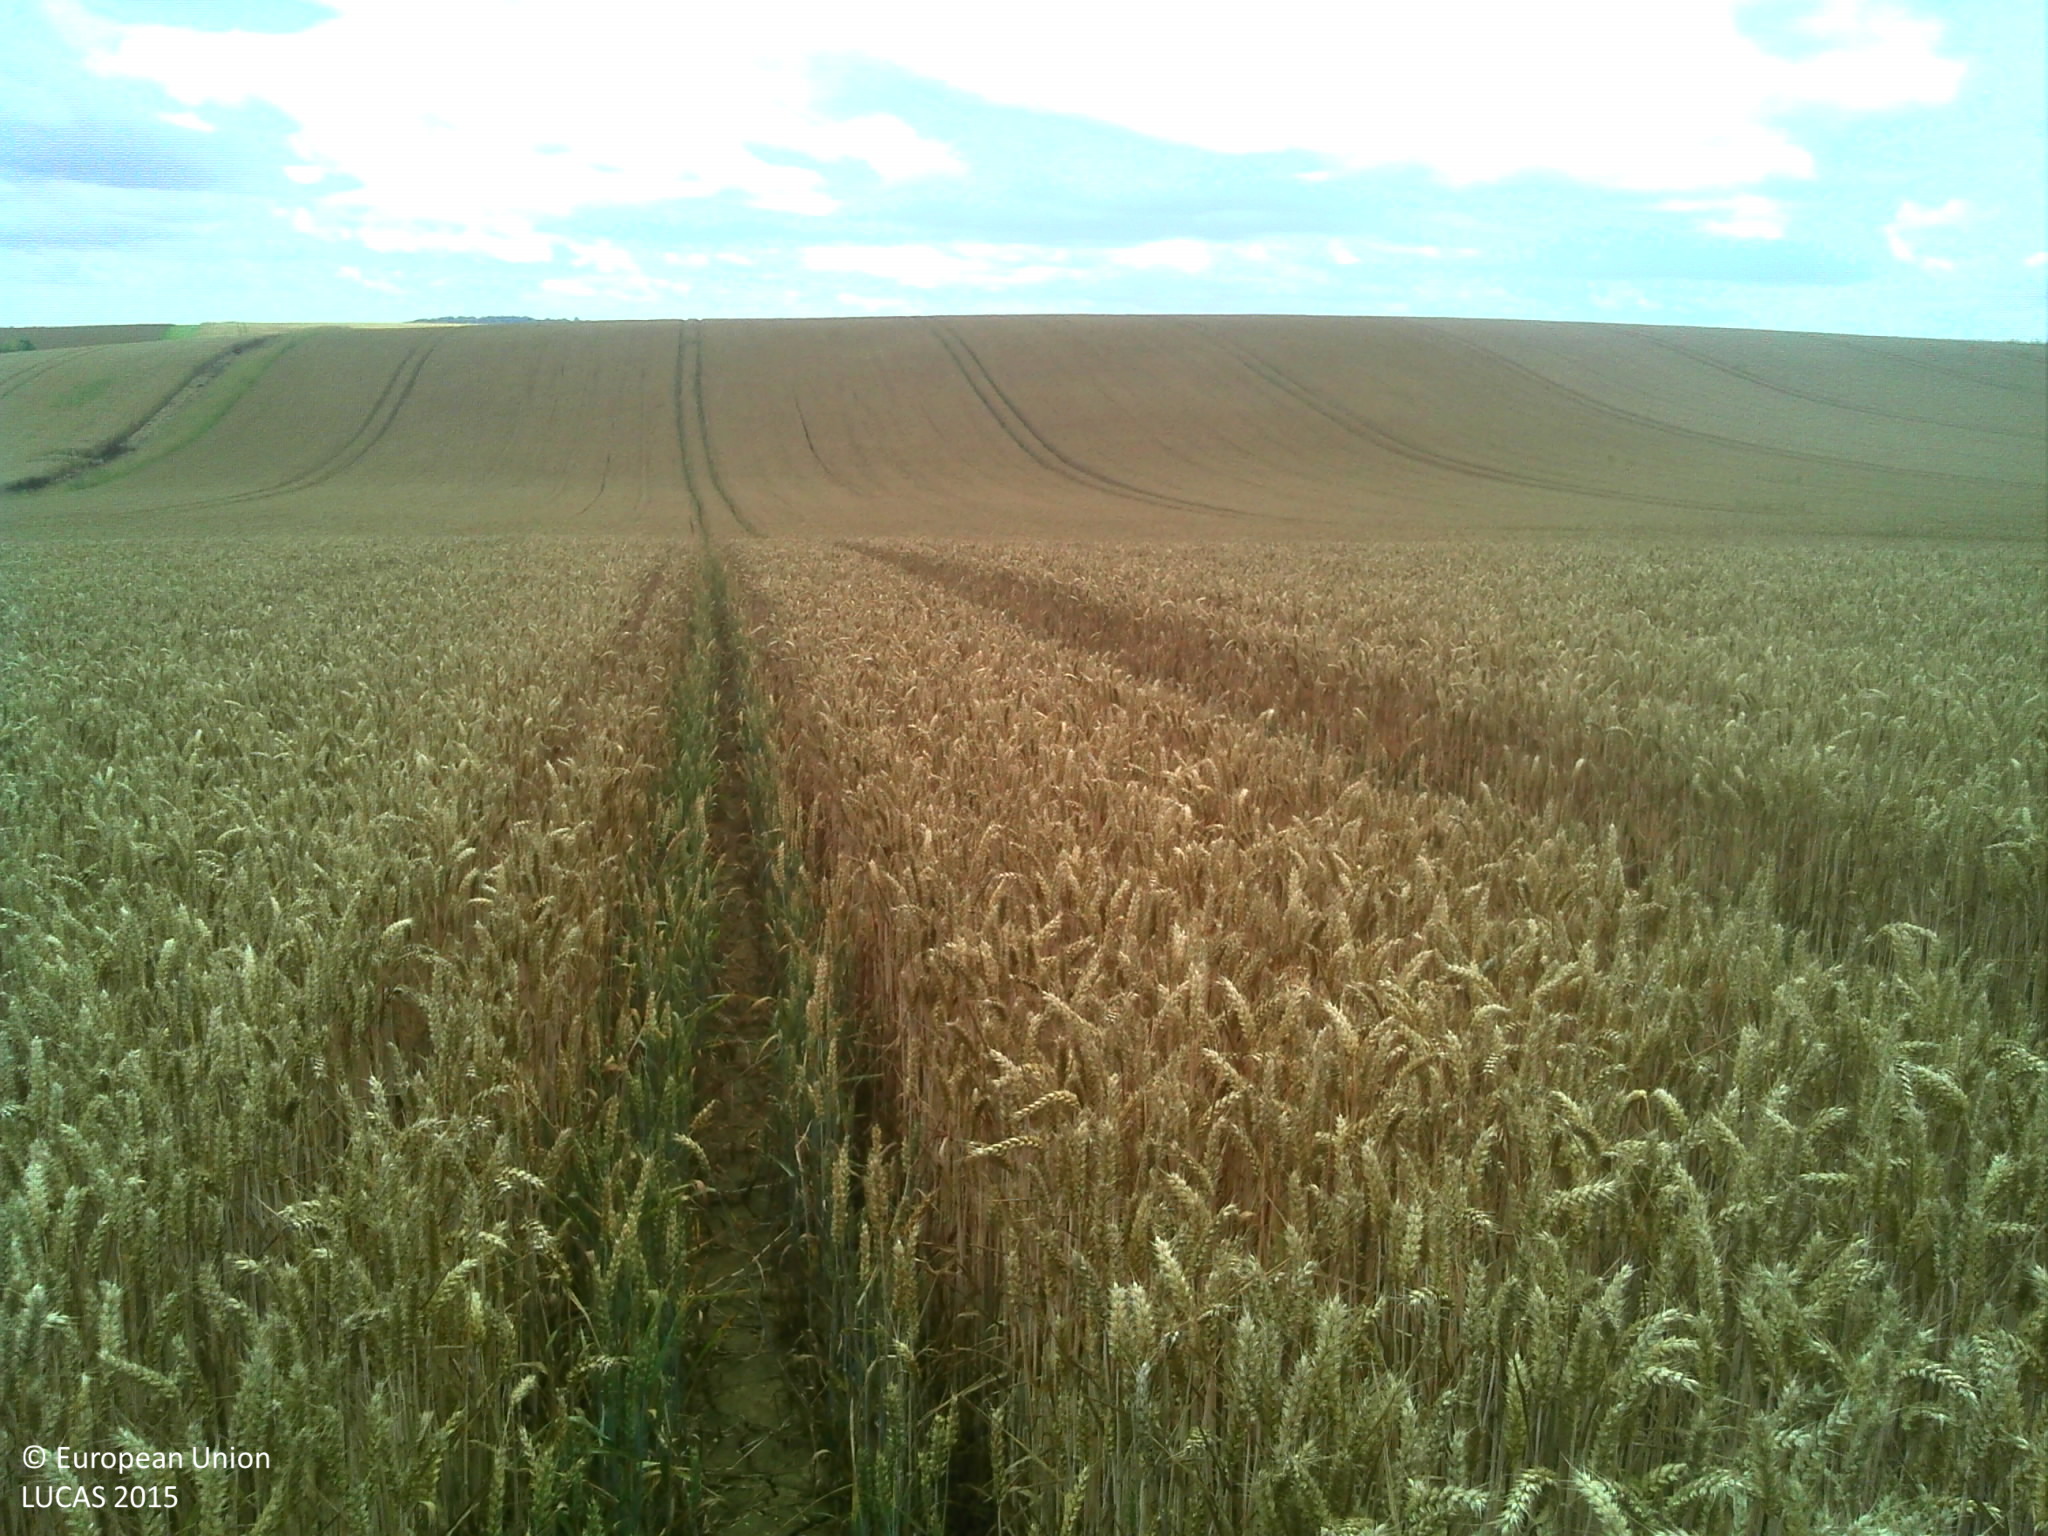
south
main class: Cropland
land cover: Common wheat
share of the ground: > 75 %
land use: Agriculture (excluding fallow land and kitchen gardens)
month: July
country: FR
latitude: 49.8621
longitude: 3.6357
